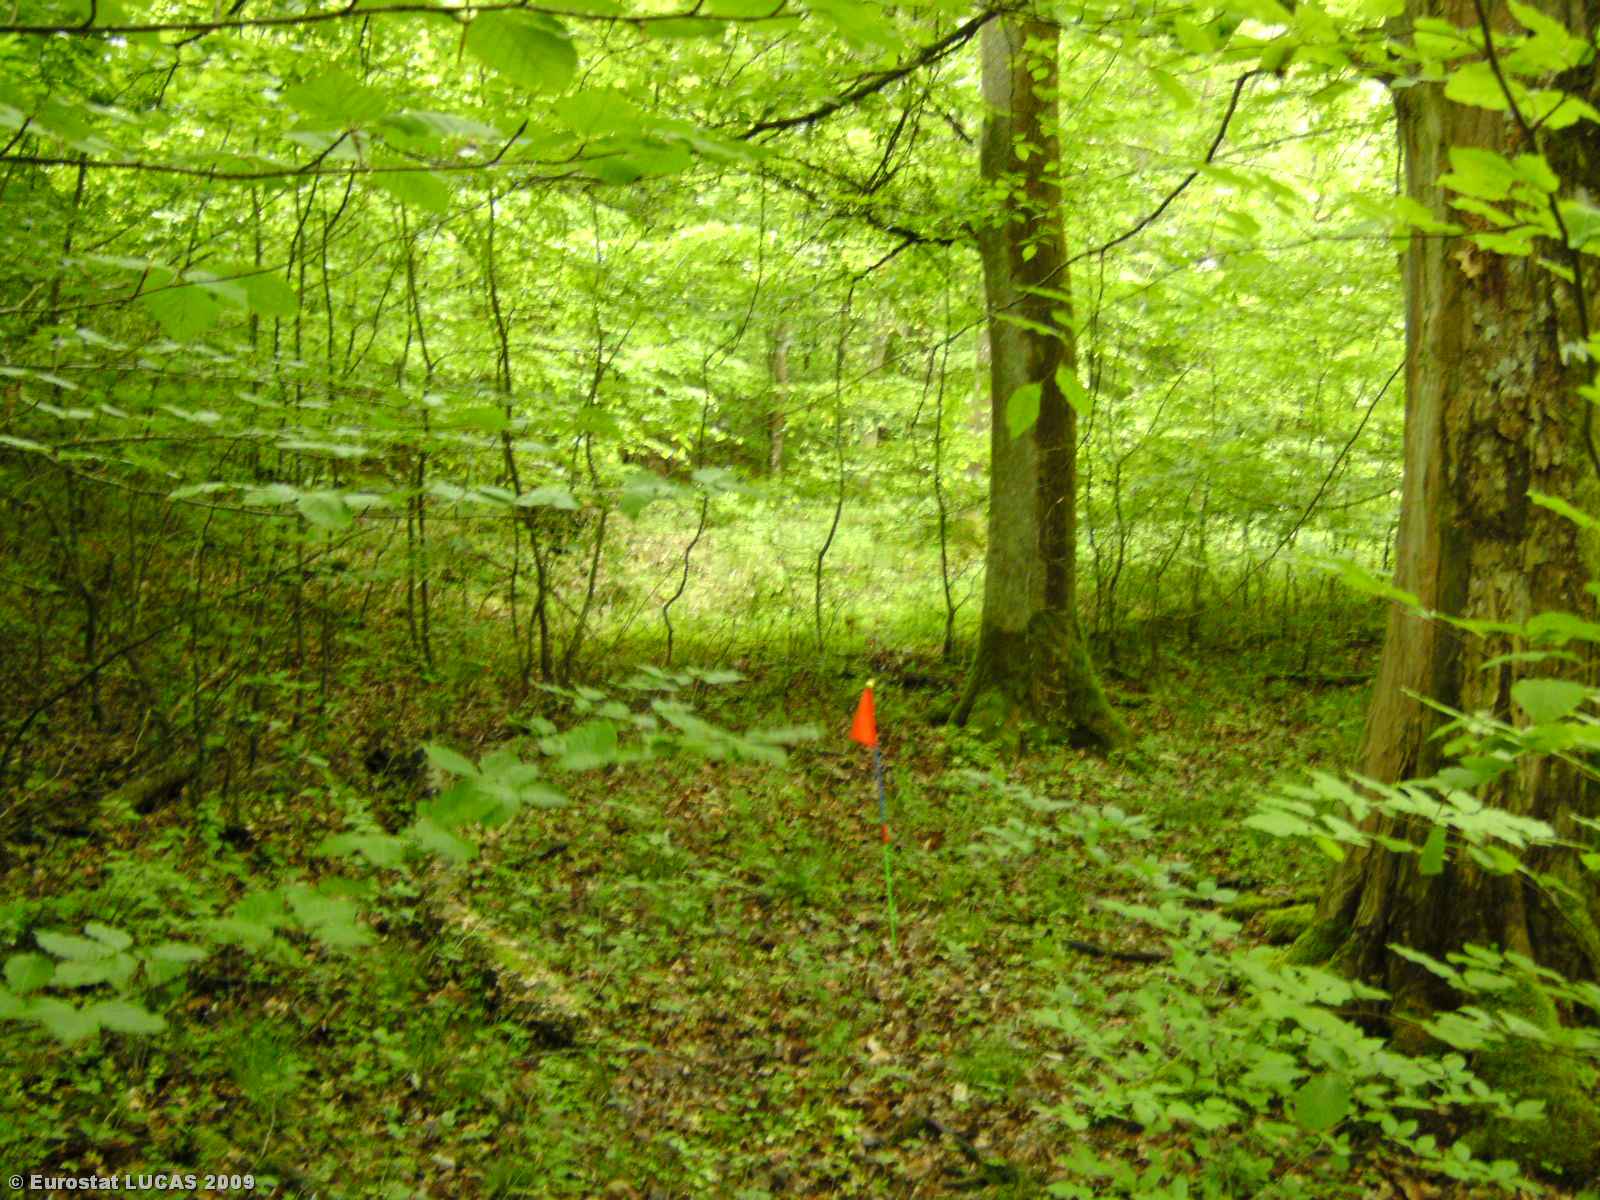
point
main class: Woodland
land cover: Broadleaved woodland
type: beech forest
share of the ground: > 75 %
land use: Forestry
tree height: > 5 m
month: May
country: LU
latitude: 49.6912
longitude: 6.2706
